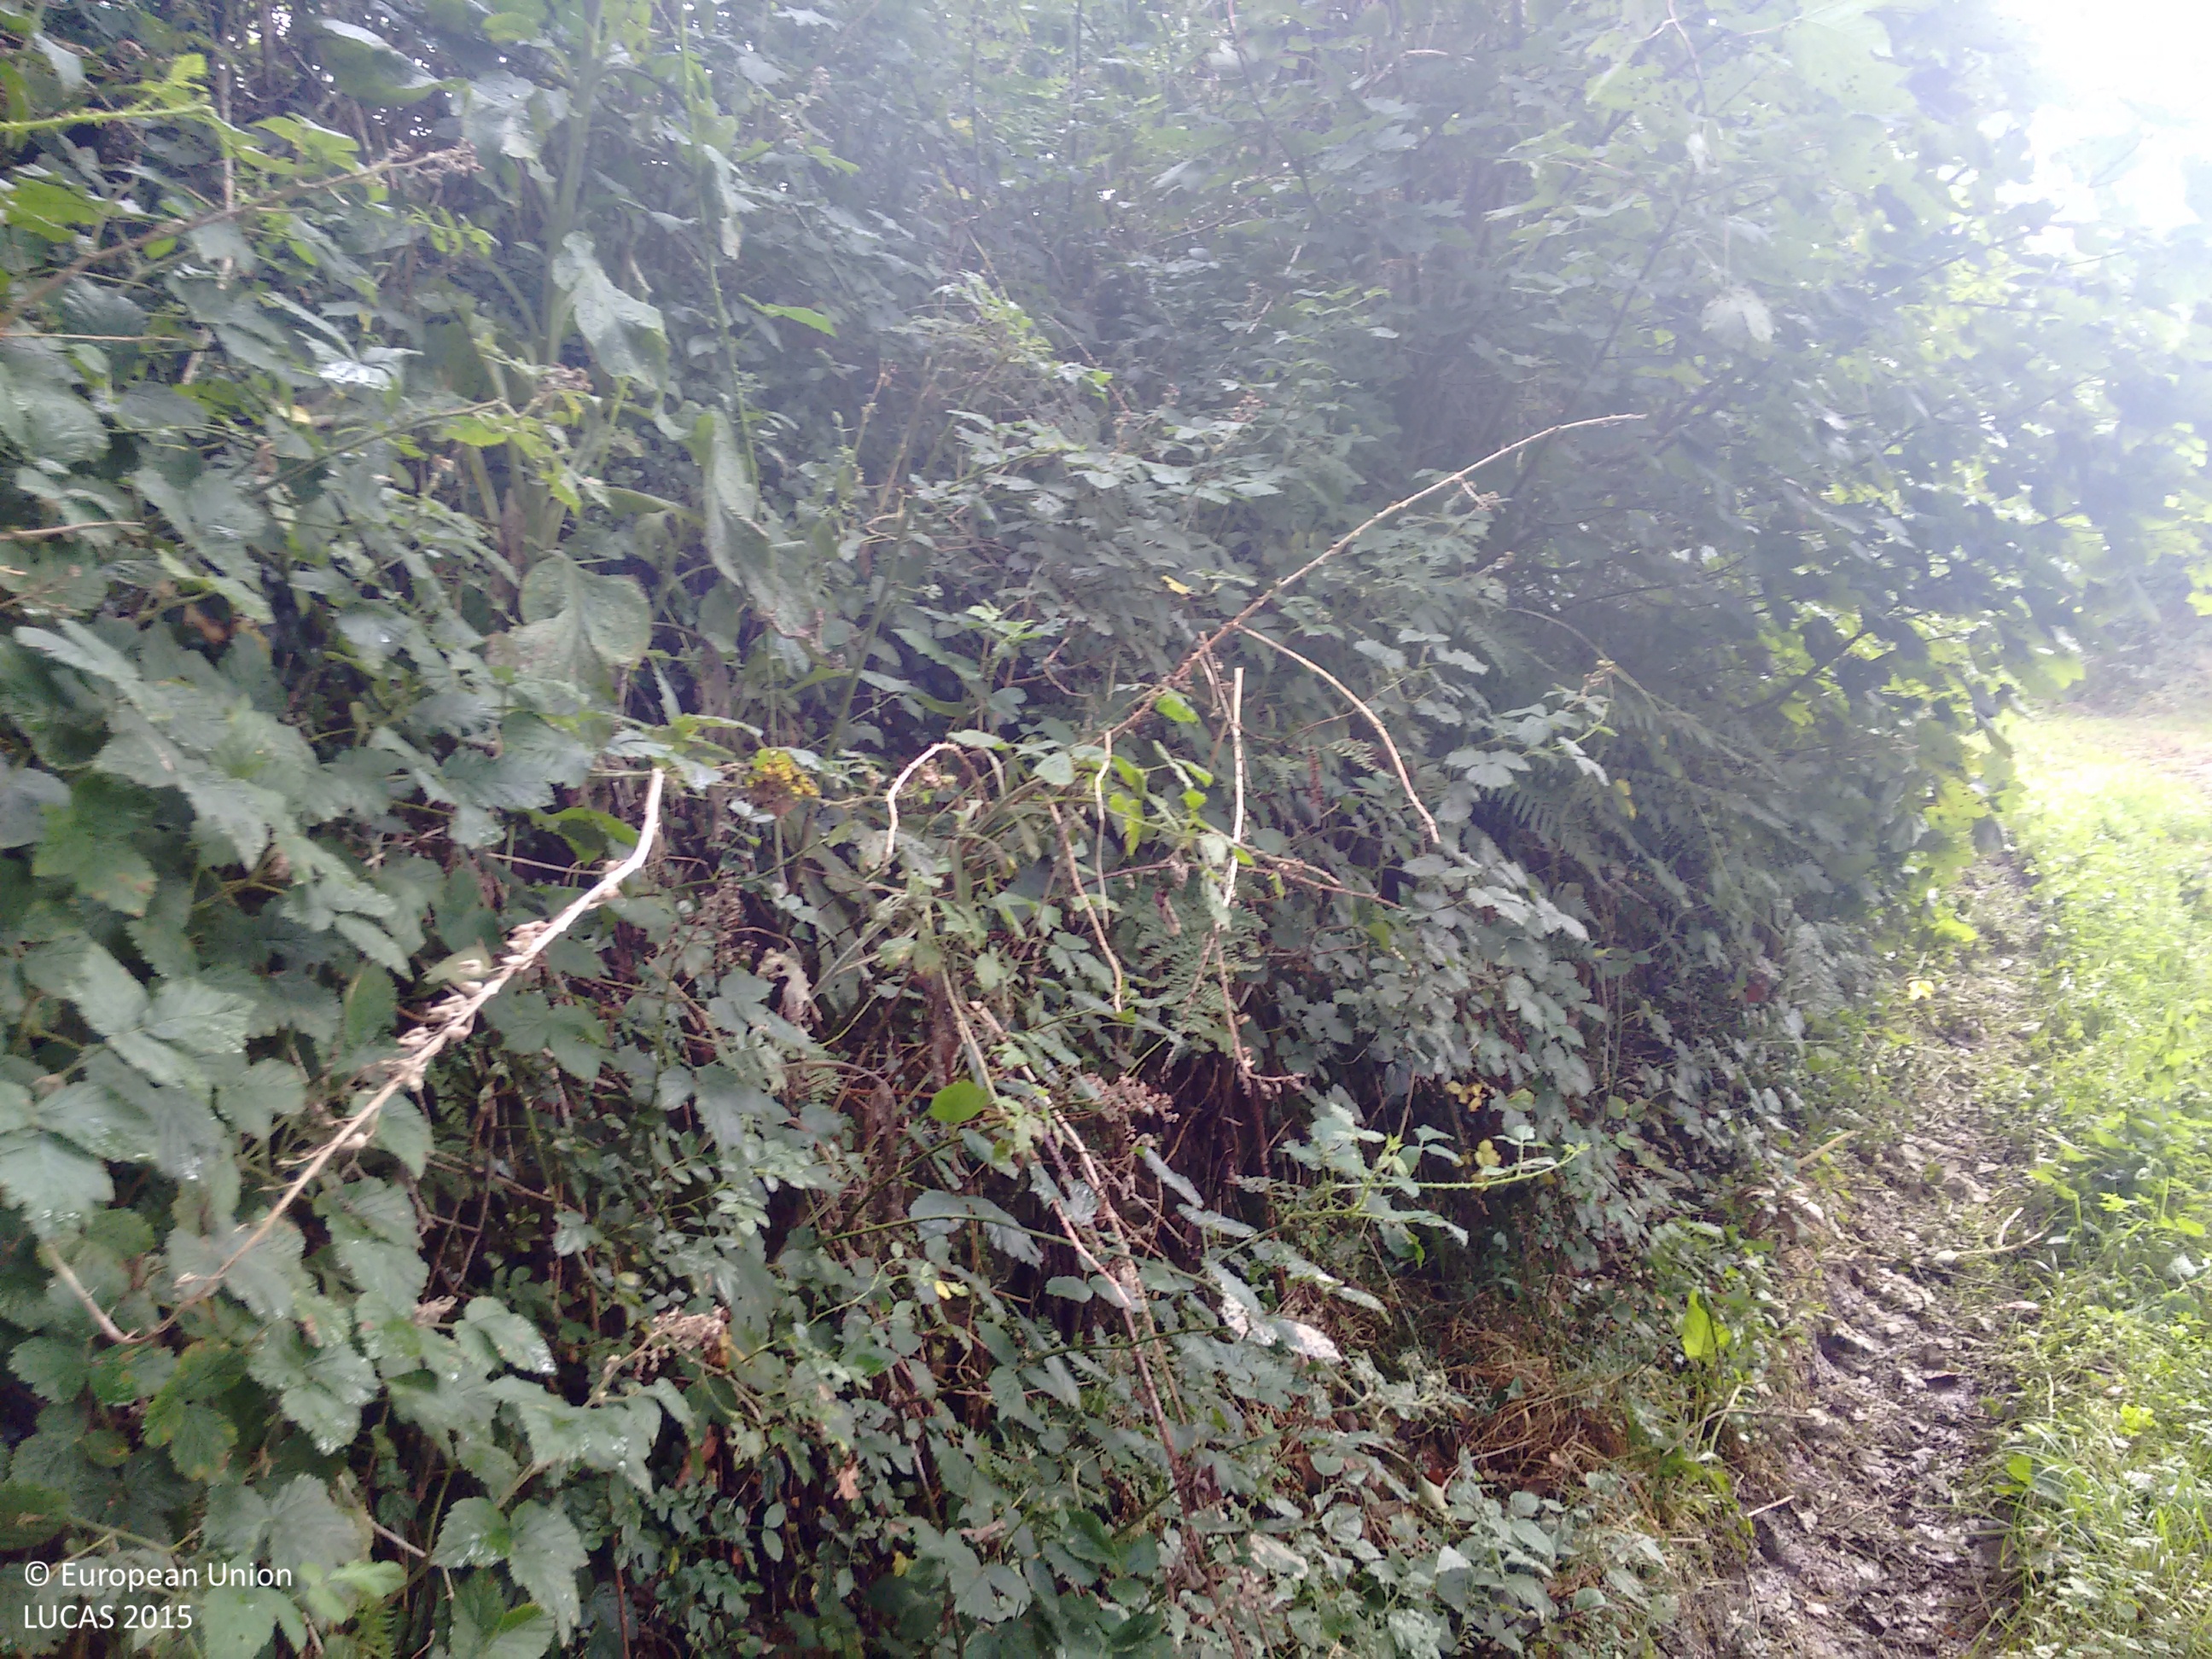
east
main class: Woodland
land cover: Broadleaved woodland
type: mesophytic deciduous forest
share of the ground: > 75 %
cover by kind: broadleaved forest trees 100 %
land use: Semi-natural and natural areas not in use
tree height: > 5 m
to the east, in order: Broadleaved woodland; Tracks; Broadleaved woodland; Fences; Grassland without tree/shrub cover; Fences; Managed hedges; Fences; Grassland without tree/shrub cover
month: September
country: GB
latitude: 50.7507
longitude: -4.4908
